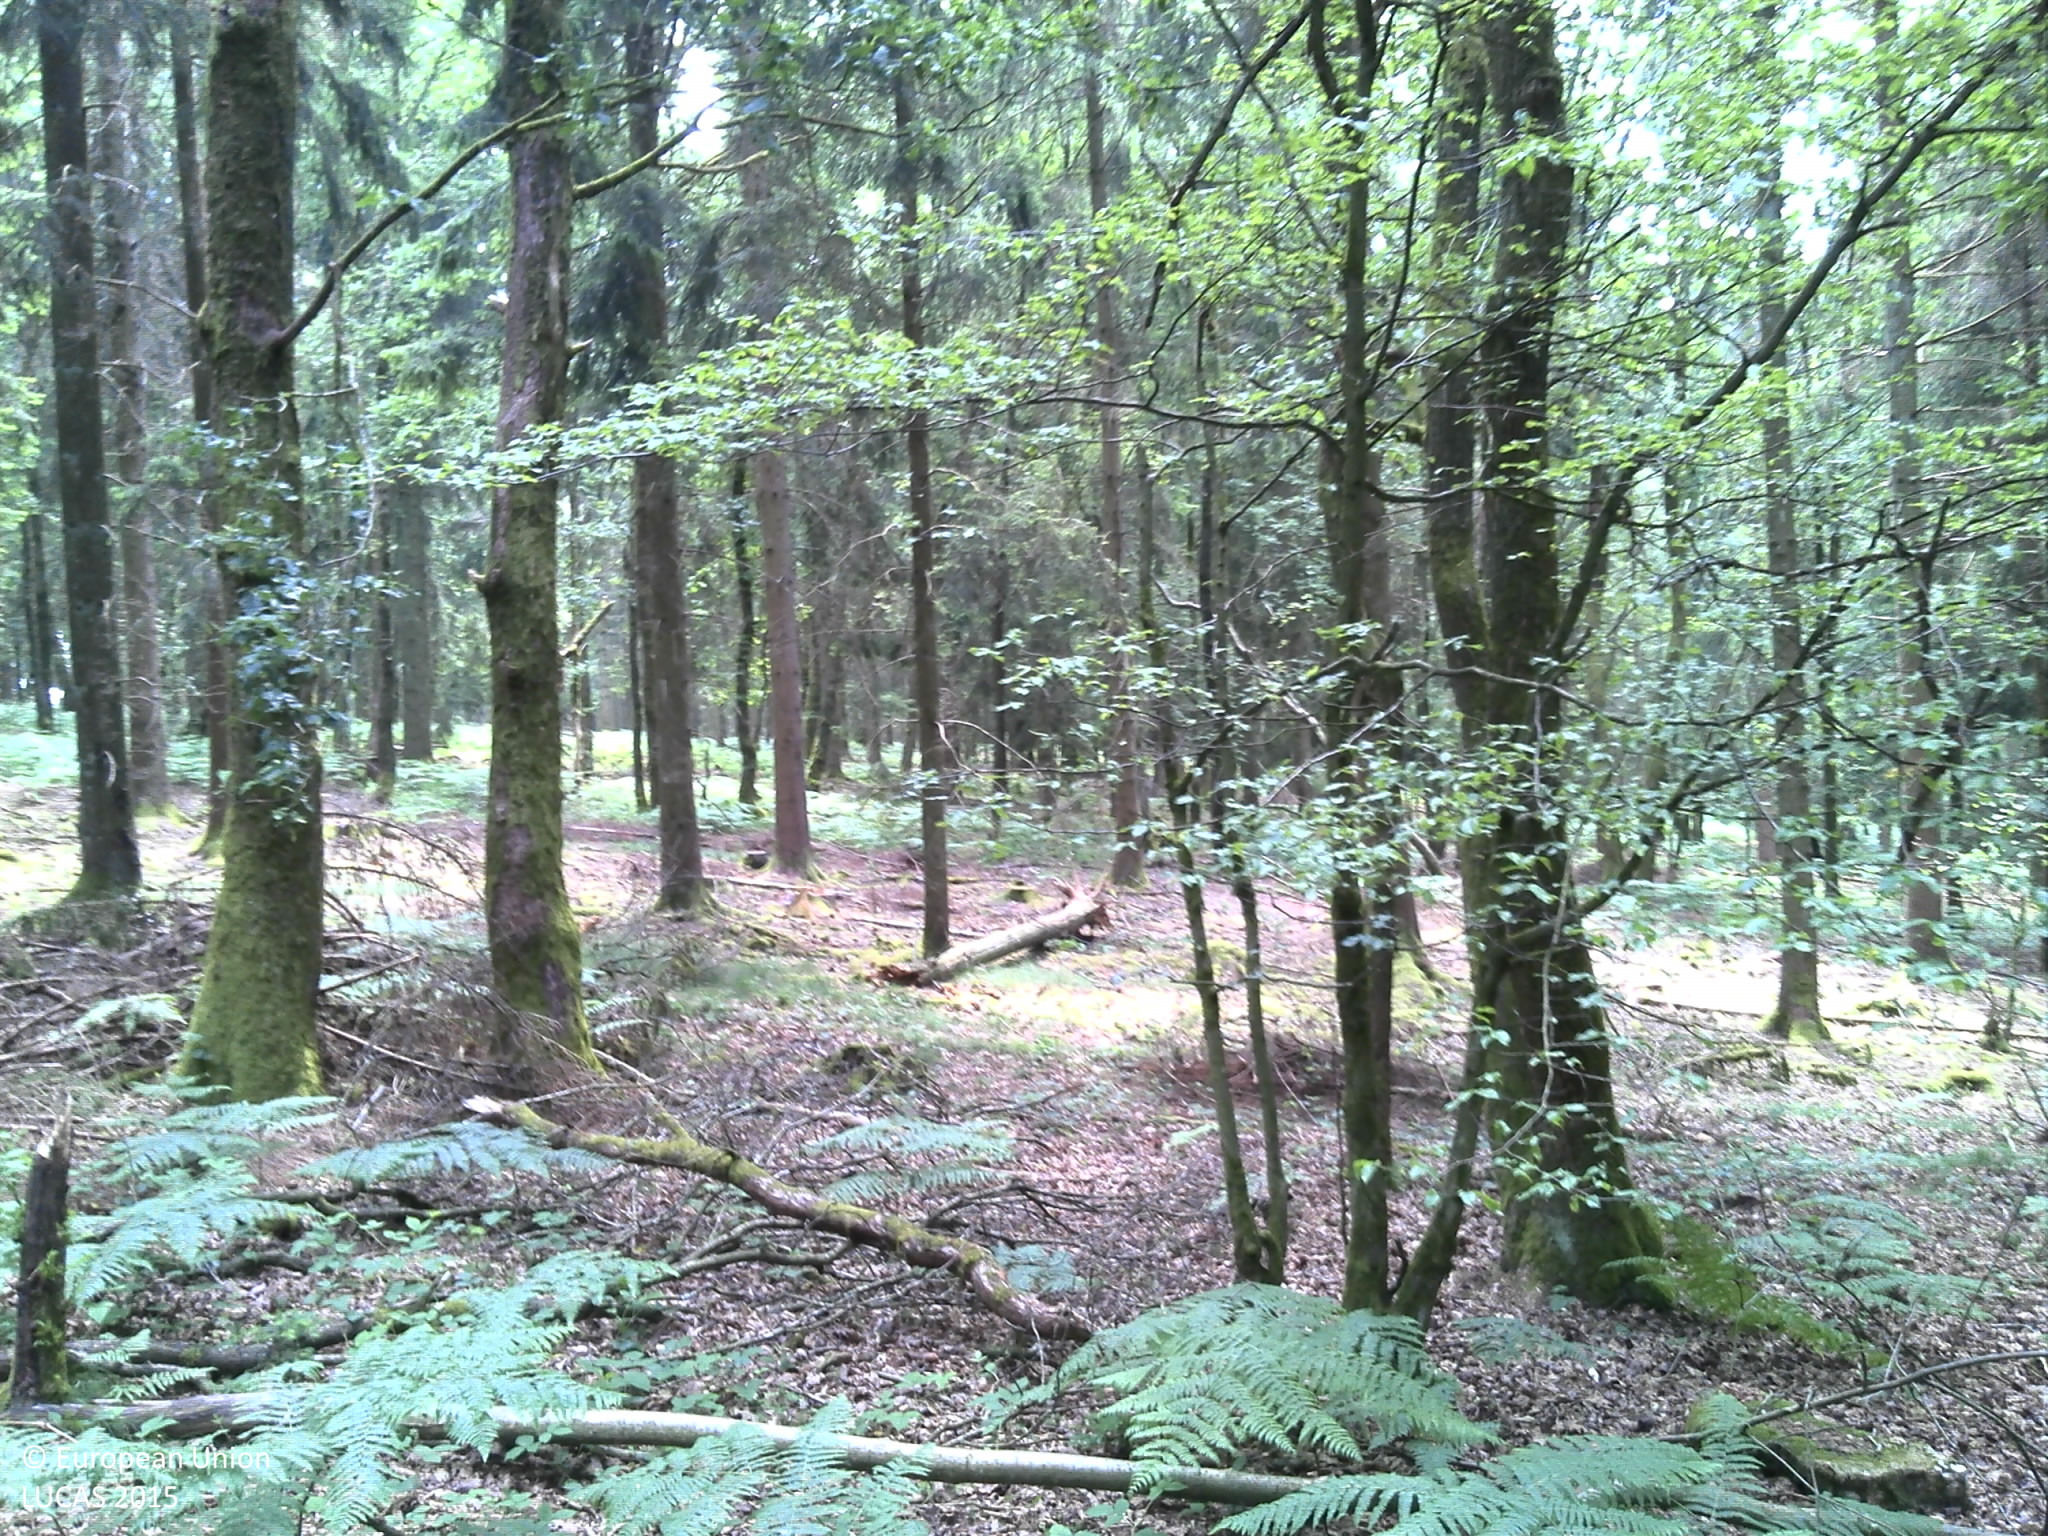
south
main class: Woodland
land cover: Spruce dominated mixed woodland
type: mountainous beech forest
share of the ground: 50 - 75 %
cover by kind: coniferous forest trees 50 %, broadleaved forest trees 25 %, herbaceous plants 10 %, lichens and mosses 10 %, consolidated bare surface 5 %
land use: Forestry
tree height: > 5 m
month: July
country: FR
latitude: 49.9177
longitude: 4.7182
